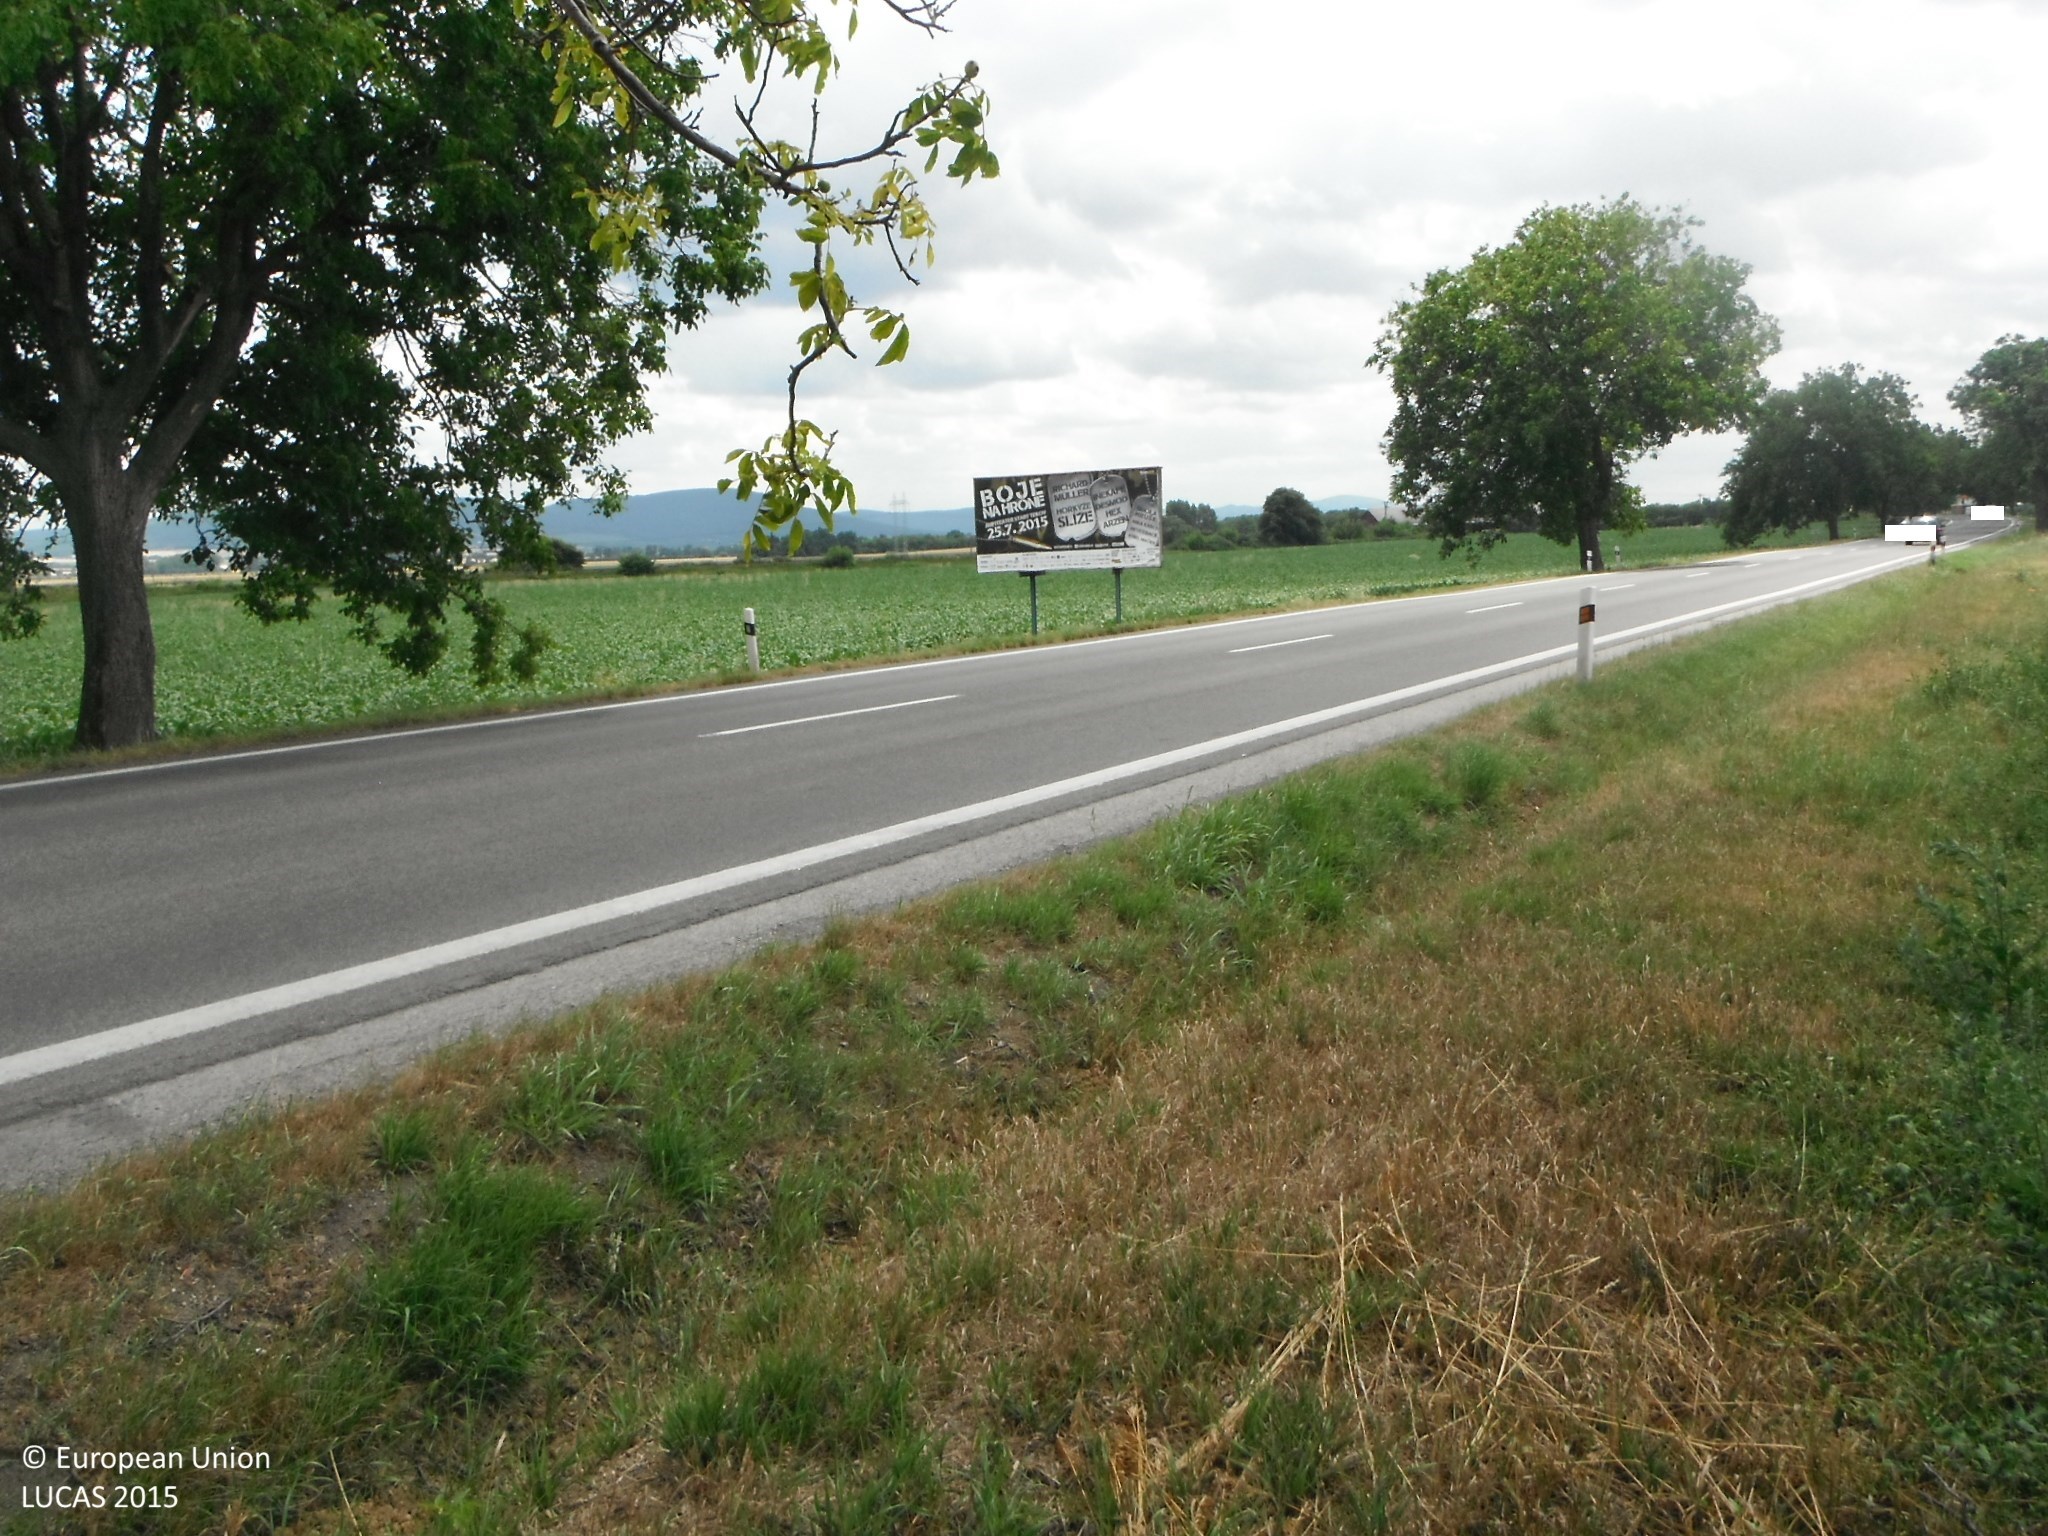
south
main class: Cropland
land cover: Maize
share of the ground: > 75 %
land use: Agriculture (excluding fallow land and kitchen gardens)
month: July
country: SK
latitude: 48.5201
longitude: 18.1242
